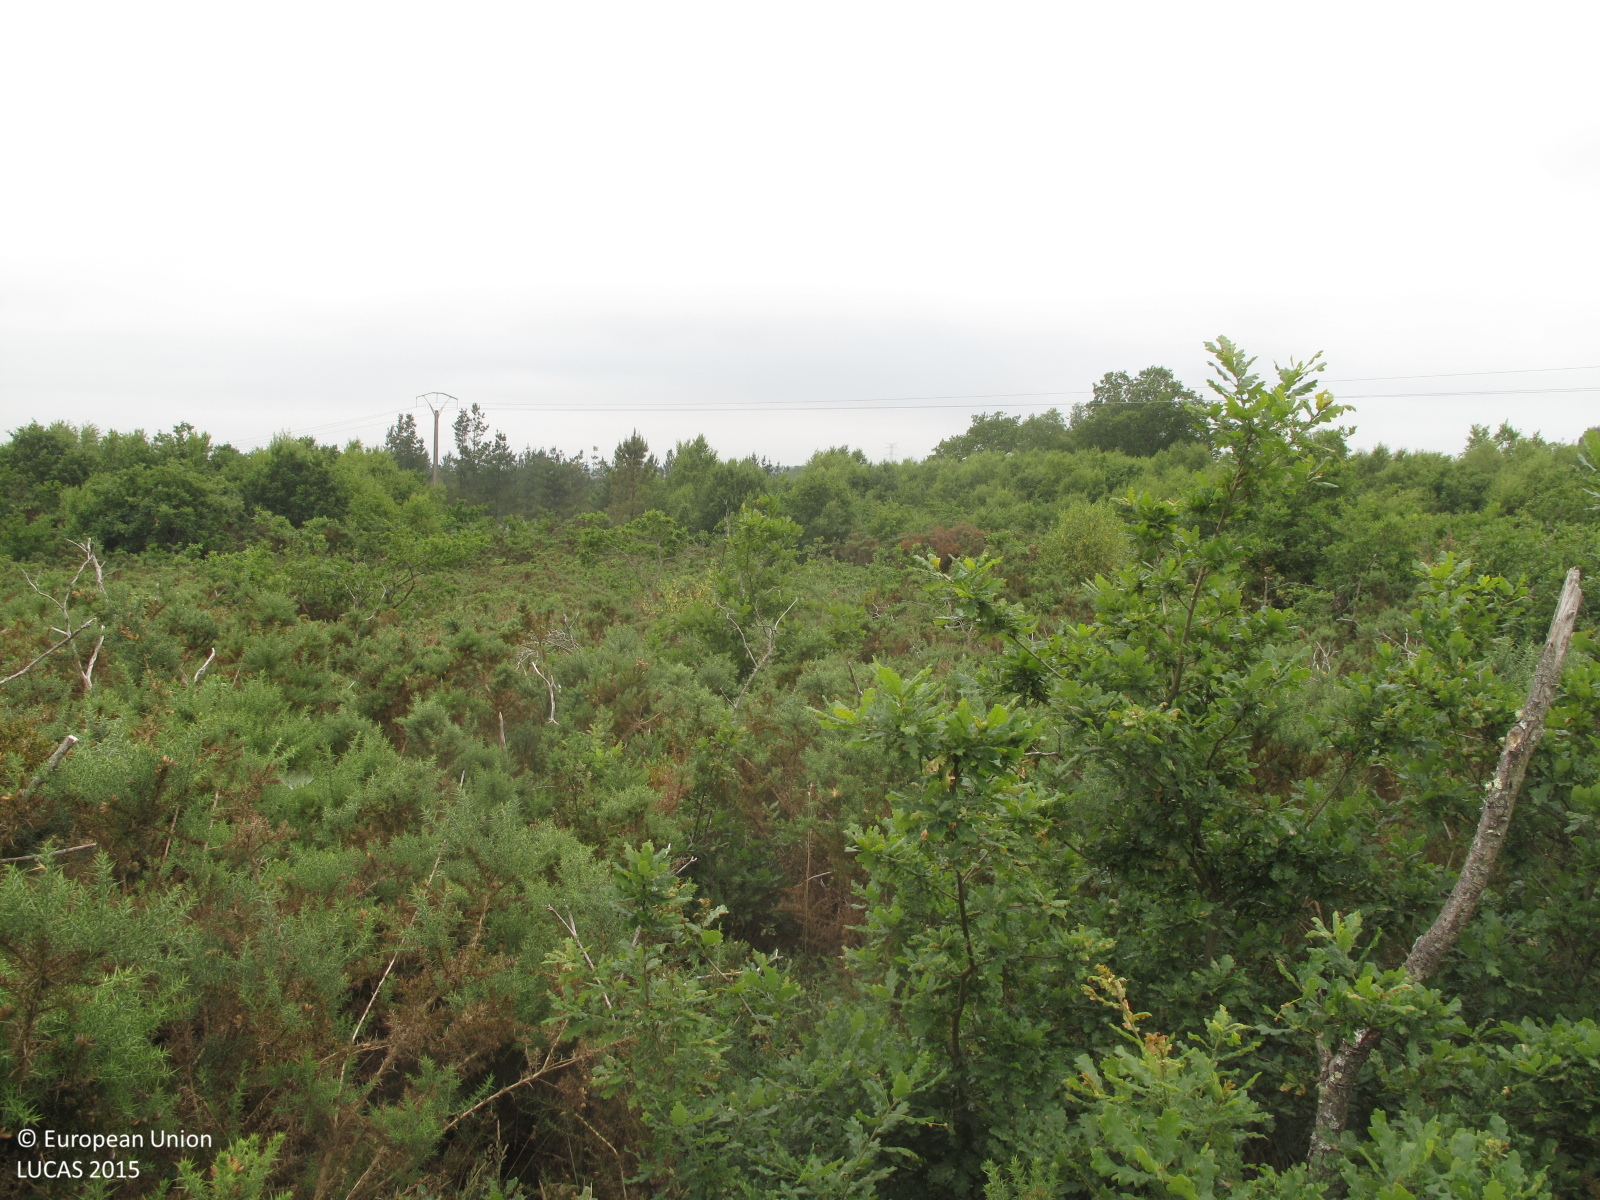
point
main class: Woodland
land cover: Broadleaved woodland
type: acidophilous oak and oak-birch forest
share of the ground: 10 - 25 %
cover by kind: shrubs 70 %, broadleaved forest trees 20 %, herbaceous plants 10 %
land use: Semi-natural and natural areas not in use
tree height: < 5 m
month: June
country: ES
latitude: 43.1729
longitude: -8.0662
